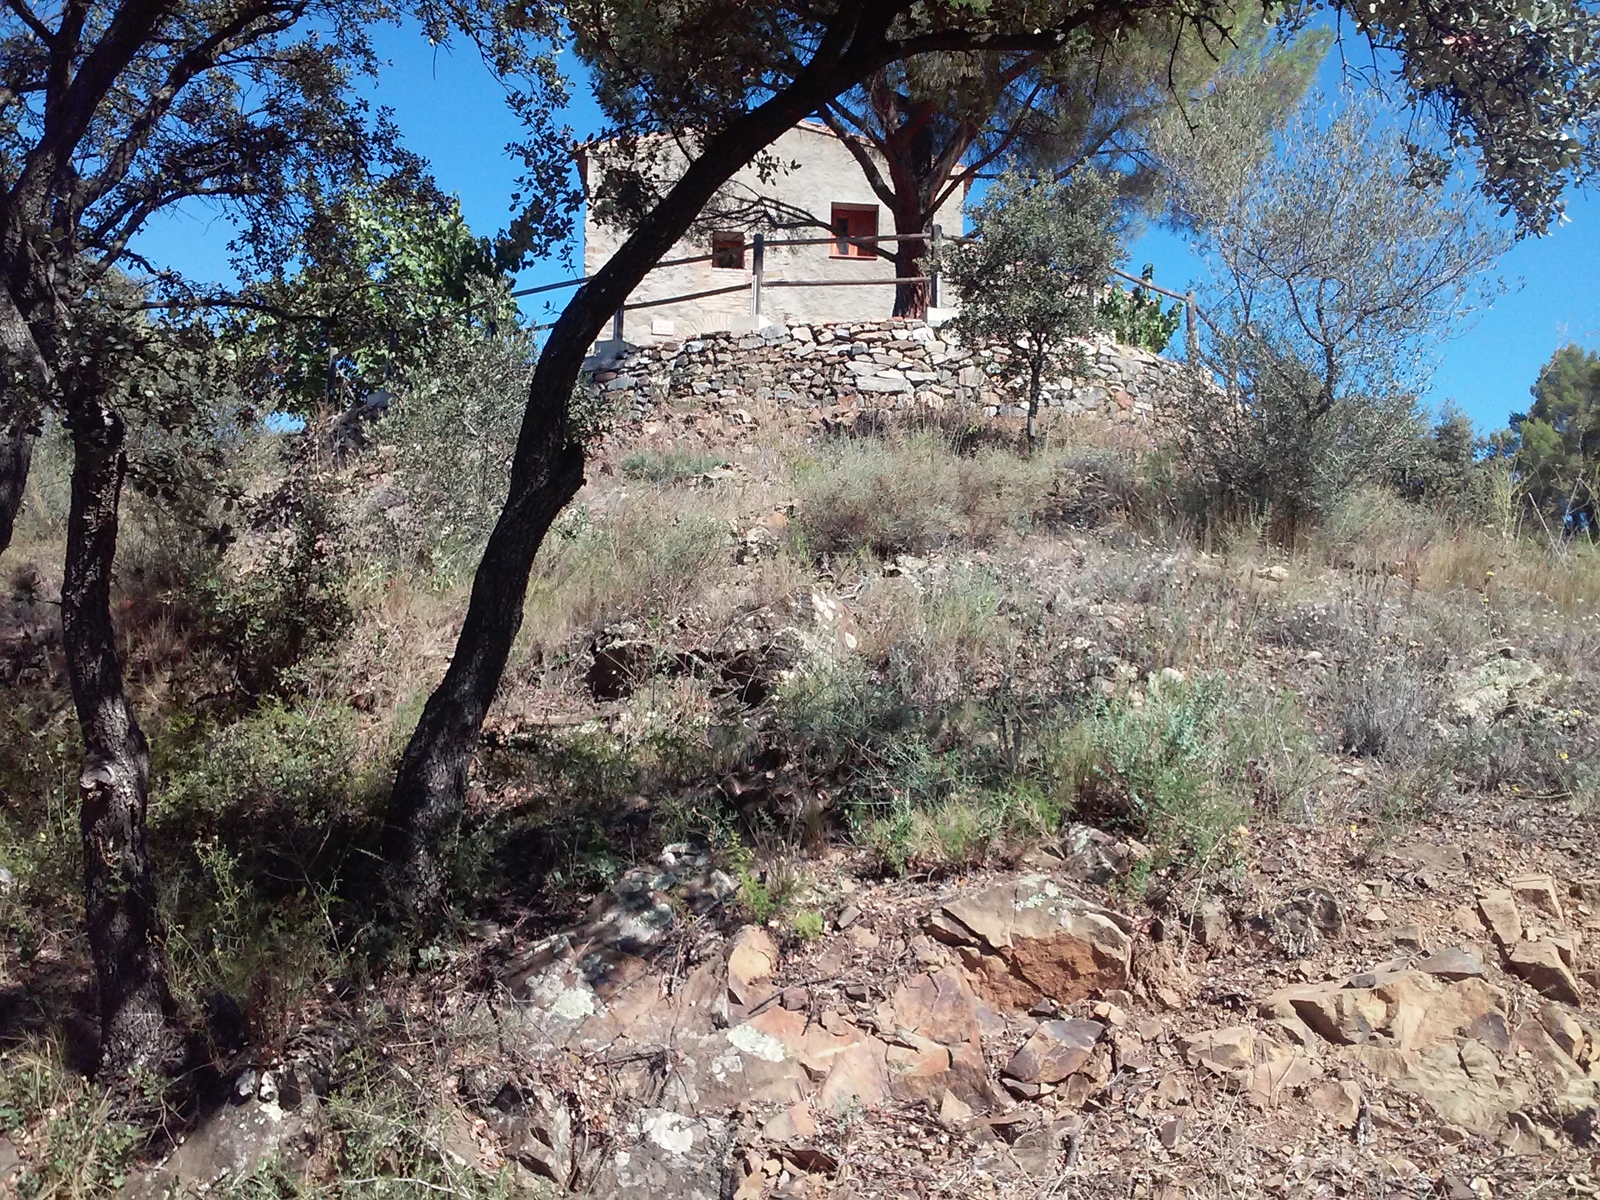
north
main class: Woodland
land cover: Pine dominated mixed woodland
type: coniferous forest of the mediterranean region
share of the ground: 50 - 75 %
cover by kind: shrubs 50 %, coniferous forest trees 25 %, broadleaved forest trees 25 %
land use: Semi-natural and natural areas not in use
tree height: < 5 m
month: September
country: ES
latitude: 41.2164
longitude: 0.7954
